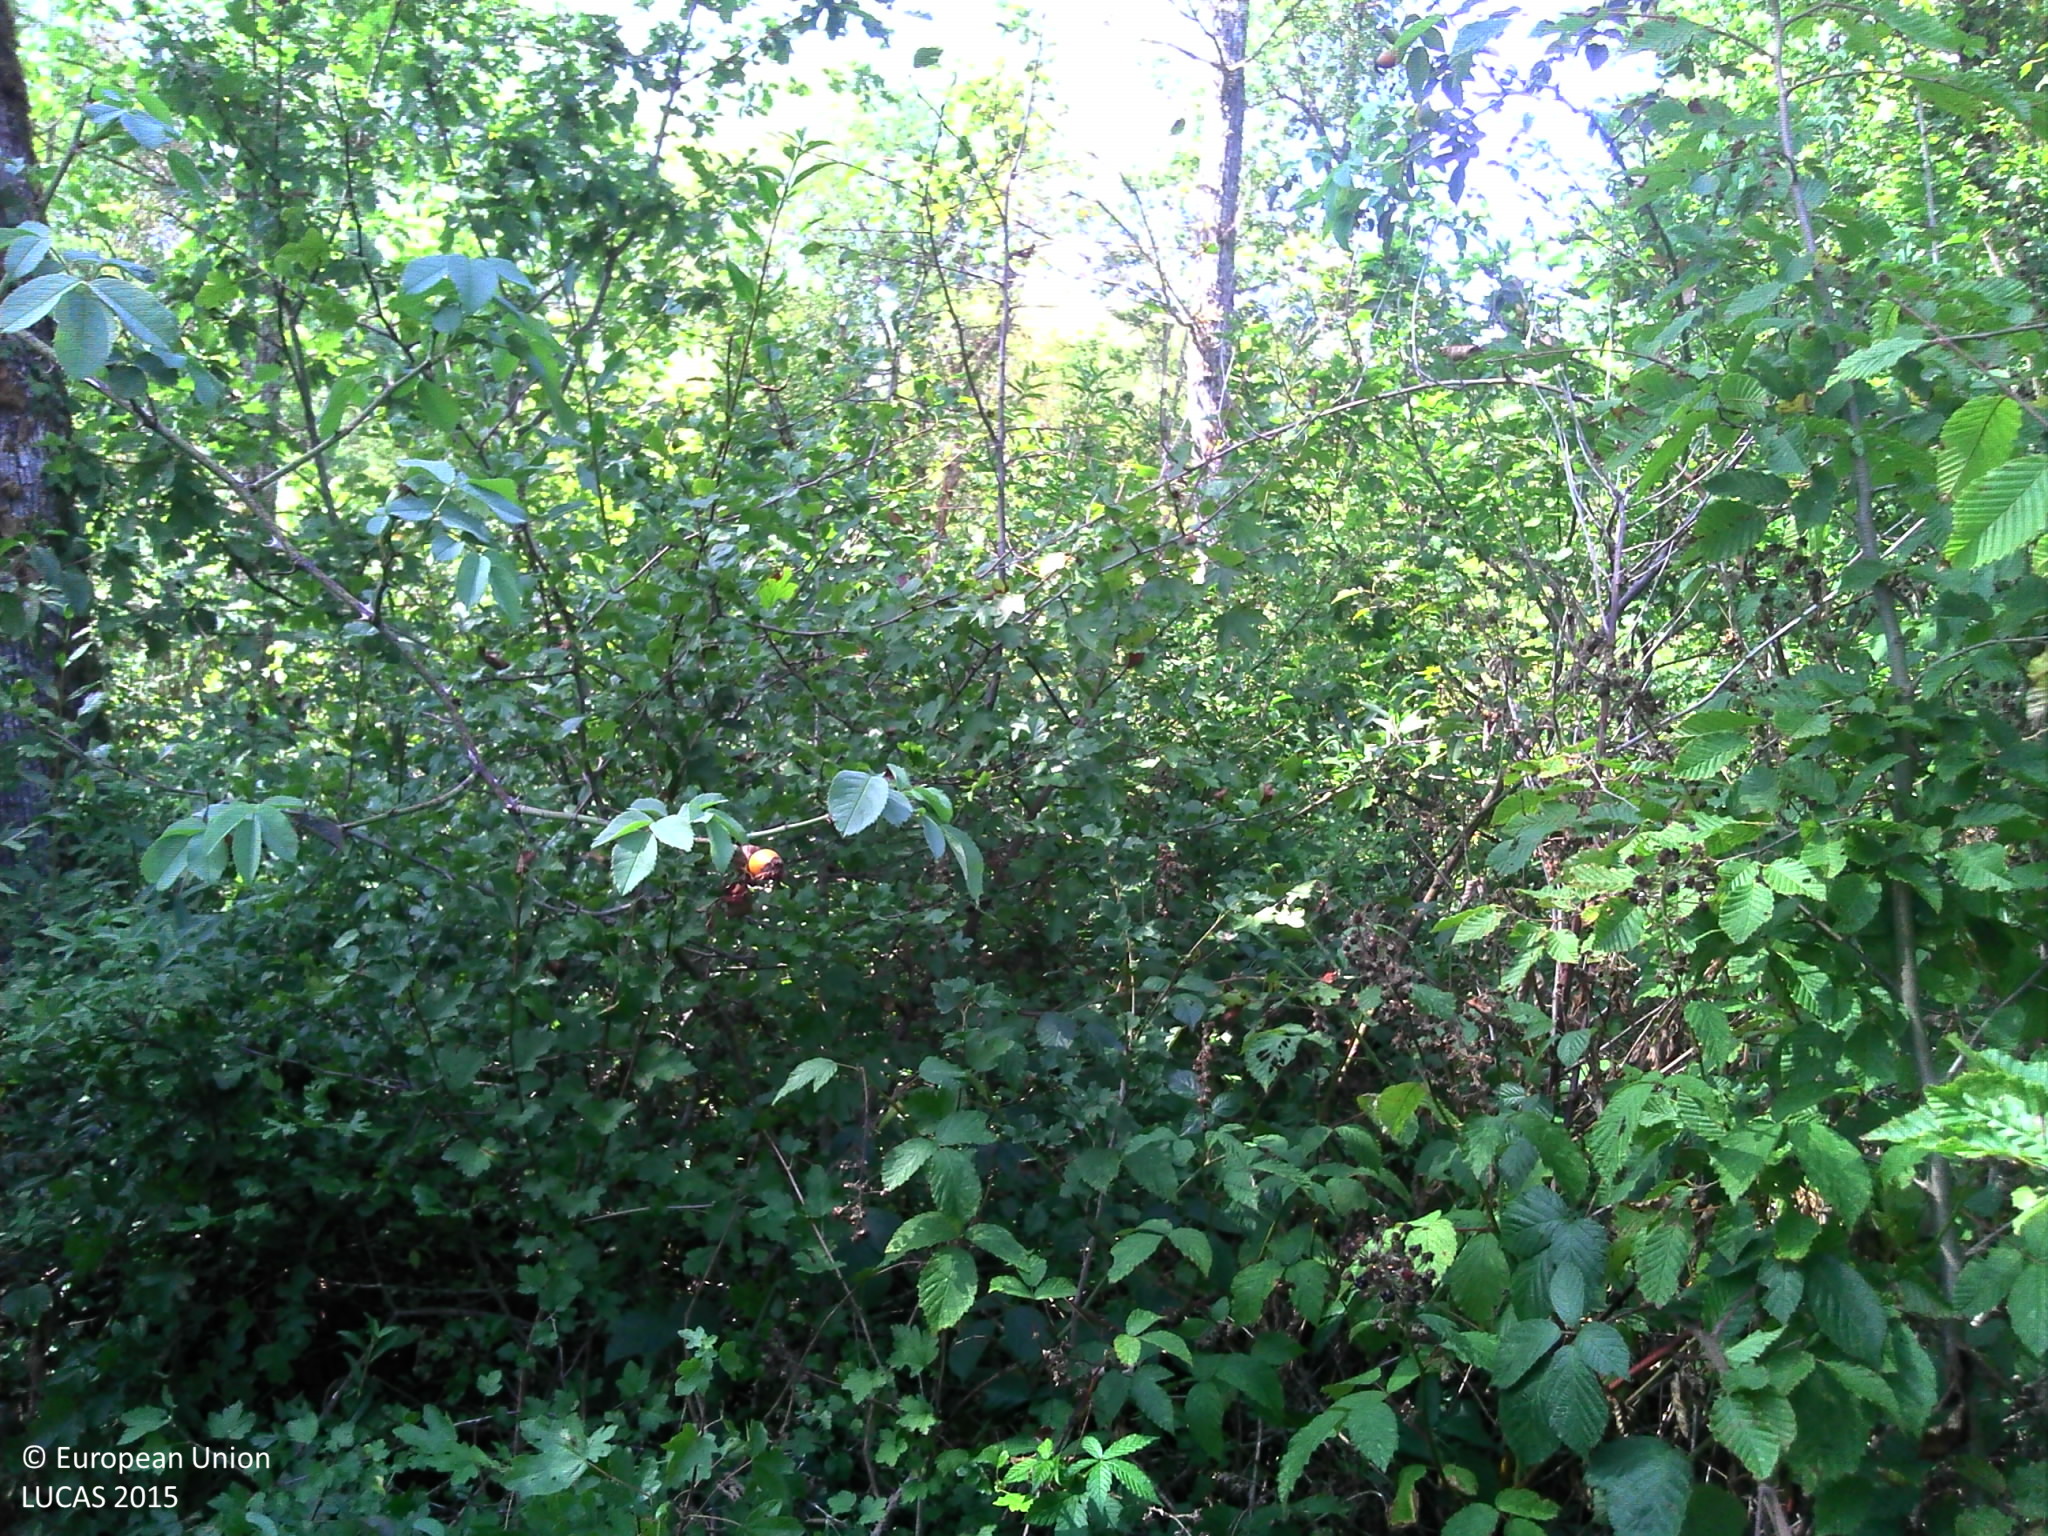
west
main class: Woodland
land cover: Broadleaved woodland
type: mesophytic deciduous forest
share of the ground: > 75 %
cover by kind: broadleaved forest trees 70 %, shrubs 20 %, herbaceous plants 10 %
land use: Forestry
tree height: > 5 m
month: August
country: FR
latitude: 47.2177
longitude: 4.8108
